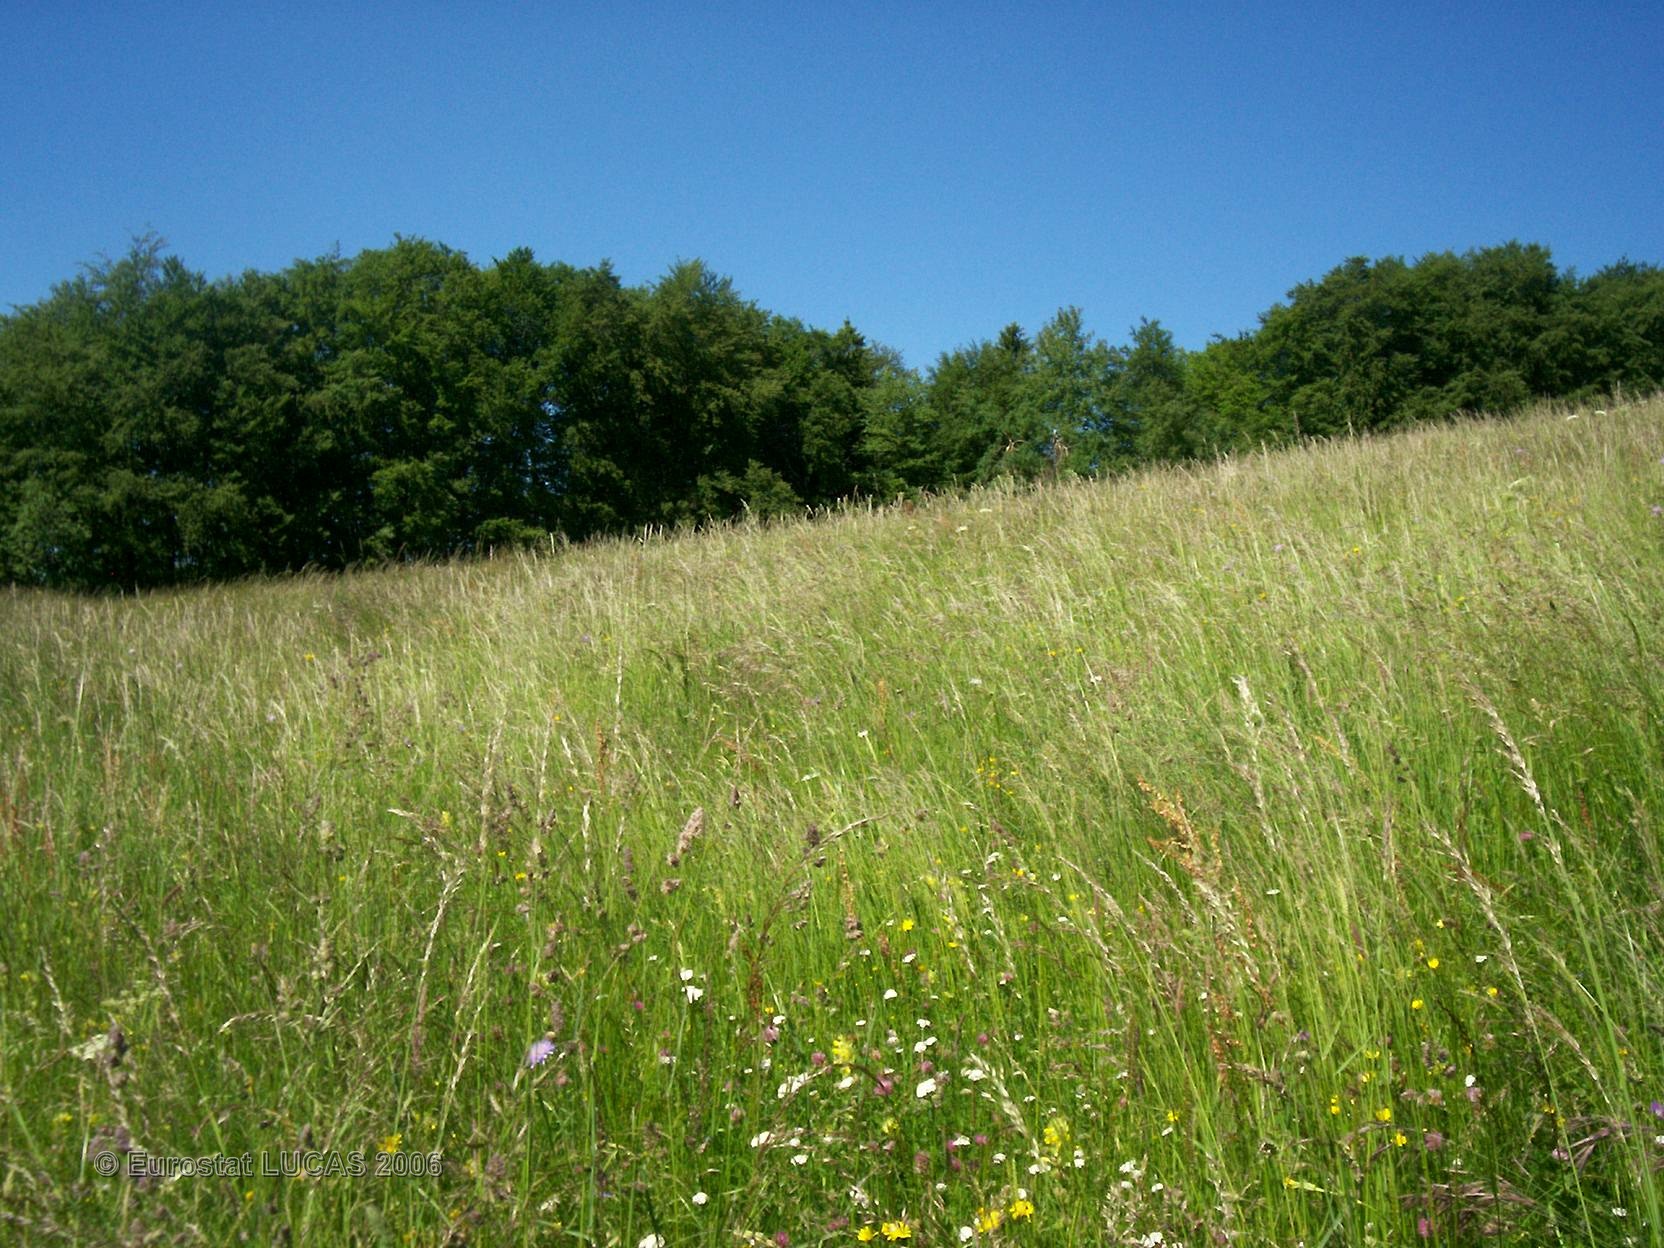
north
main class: Grassland
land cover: Grassland with sparse tree/shrub cover
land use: Agriculture (excluding fallow land and kitchen gardens)
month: June
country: FR
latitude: 46.1650
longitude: 6.4161
